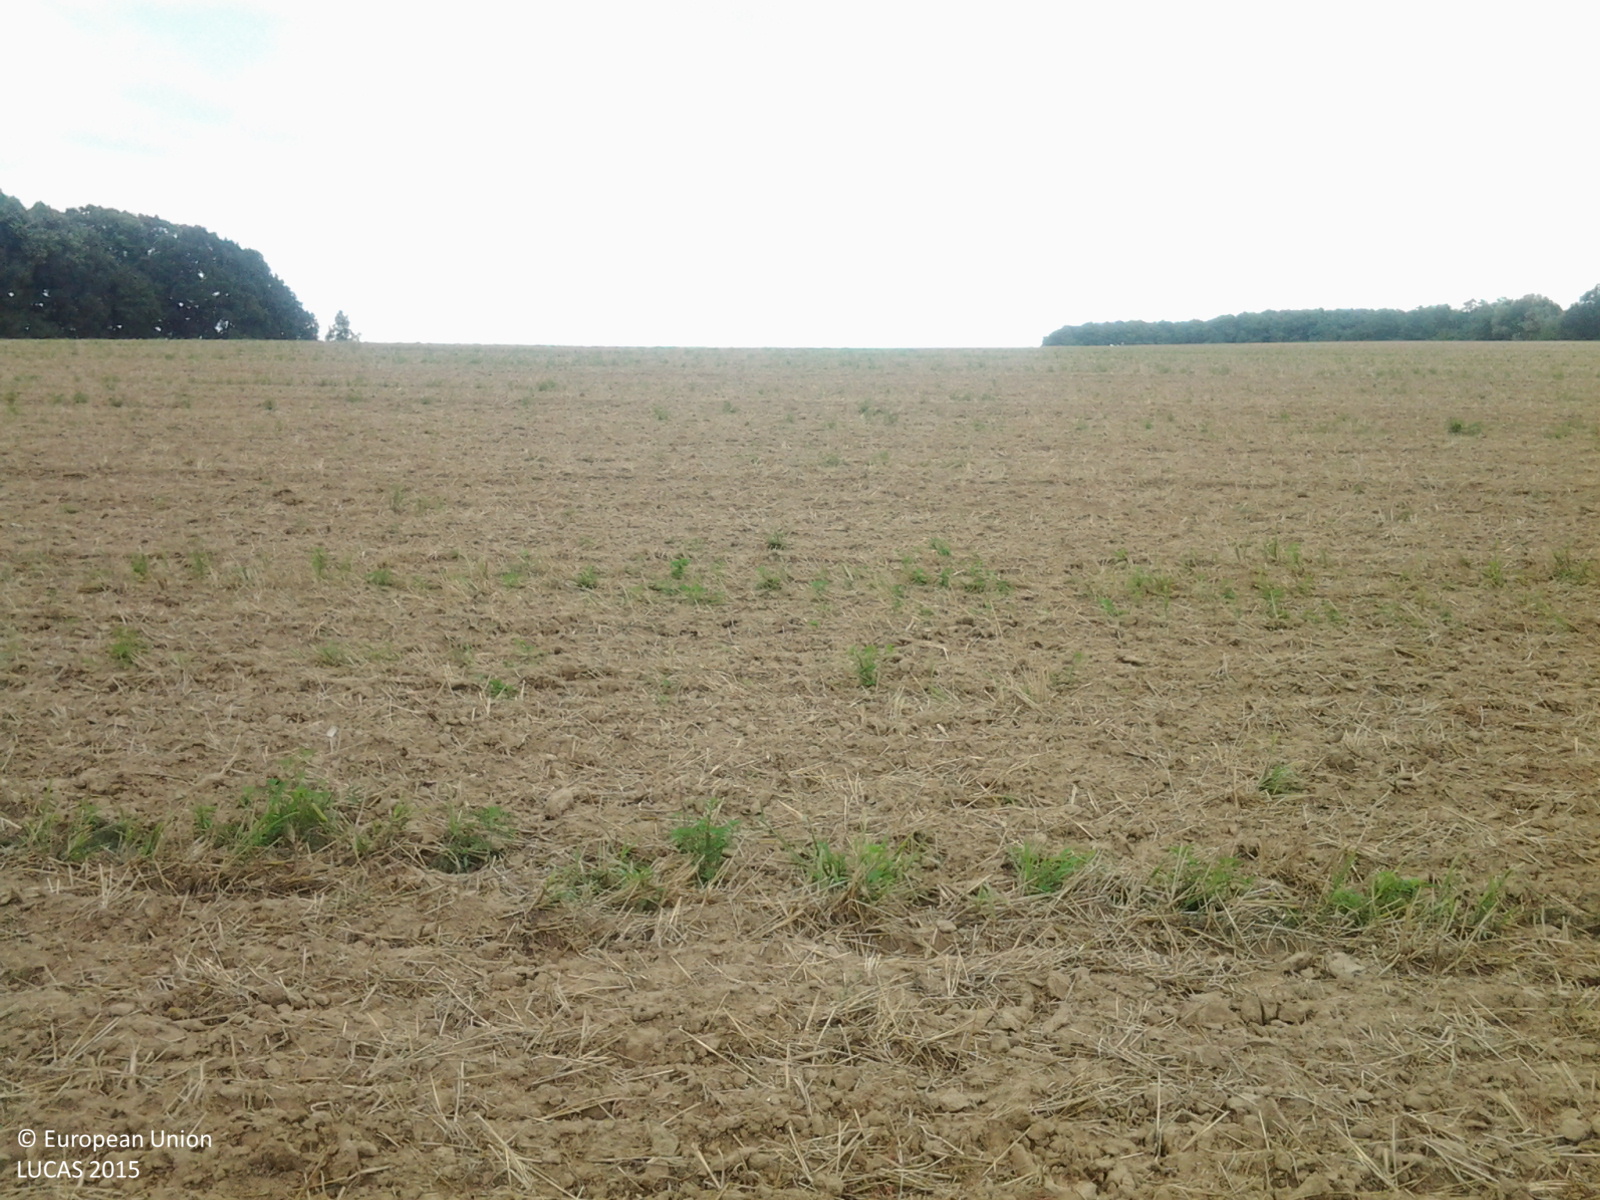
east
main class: Cropland
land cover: Common wheat
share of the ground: < 10 %
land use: Agriculture (excluding fallow land and kitchen gardens)
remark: Harvested field
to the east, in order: Common wheat
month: July
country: HU
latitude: 46.2008
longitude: 17.6897
